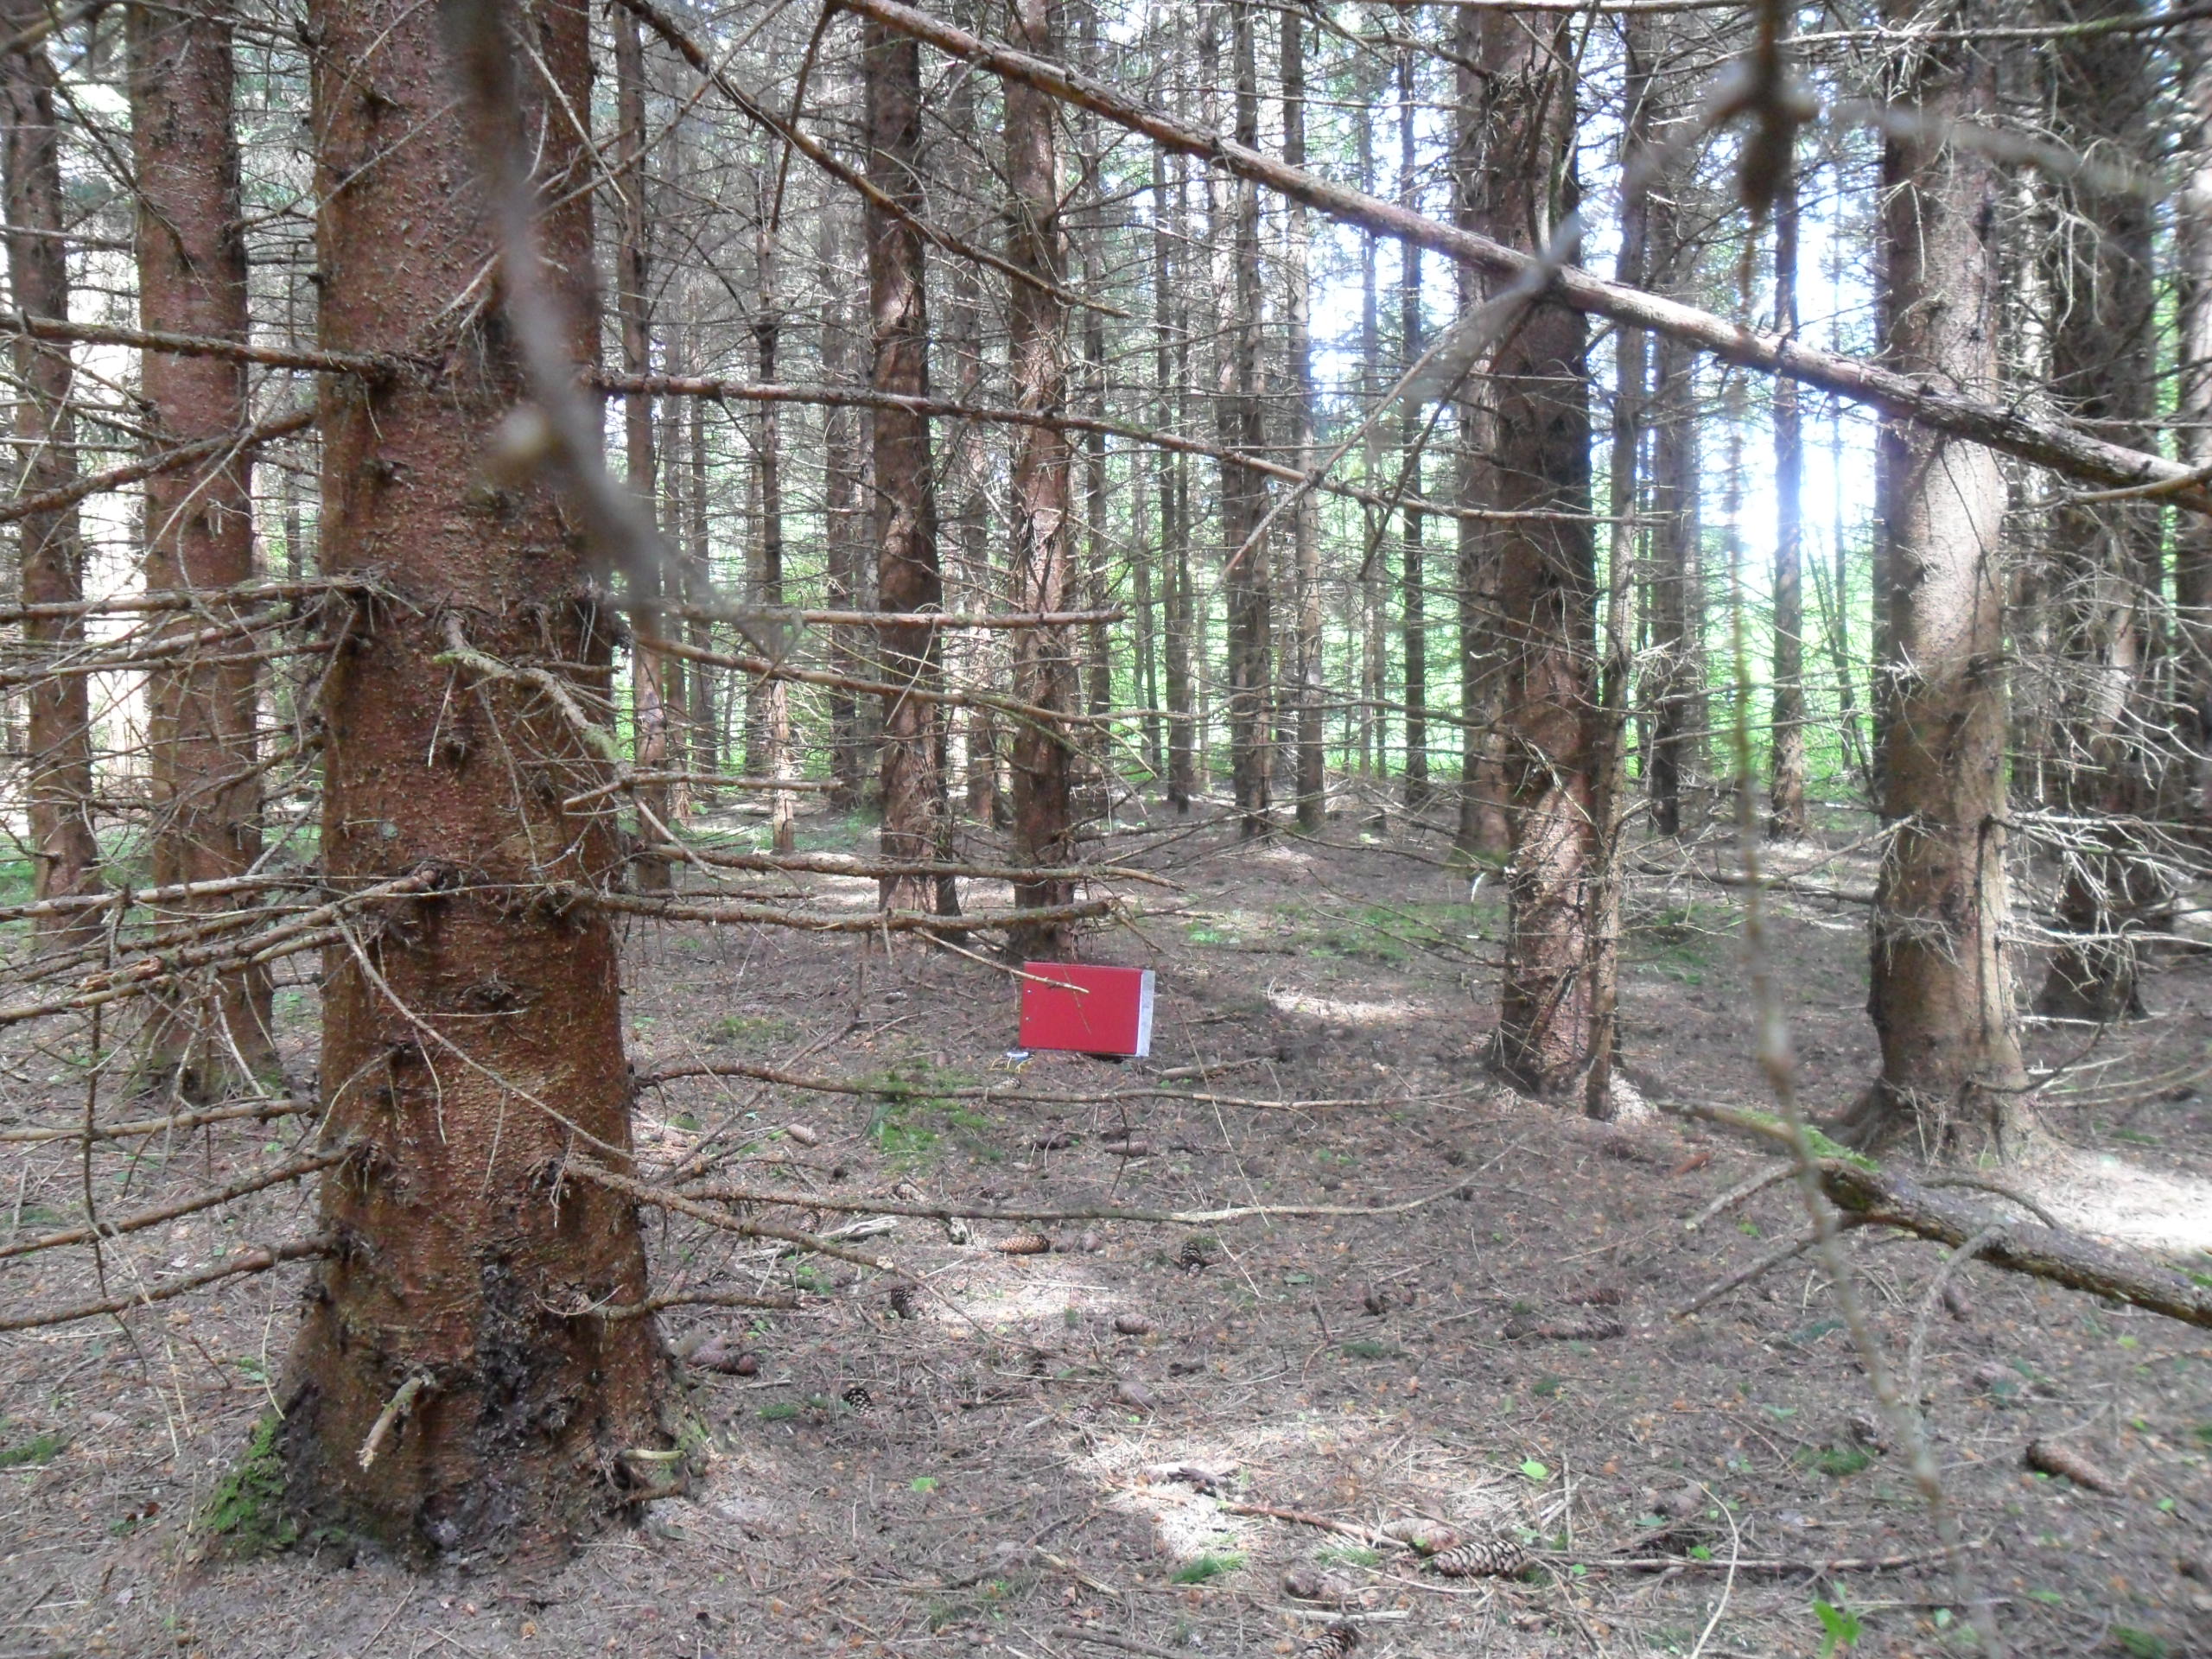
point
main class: Woodland
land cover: Spruce dominated coniferous woodland
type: hemiboreal forest and nemoral coniferous forest and mixed broadleaved-coniferous forest
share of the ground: > 75 %
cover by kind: coniferous forest trees 100 %
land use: Forestry
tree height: > 5 m
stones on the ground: < 10 %
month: June
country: LV
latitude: 57.4391
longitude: 22.4299
